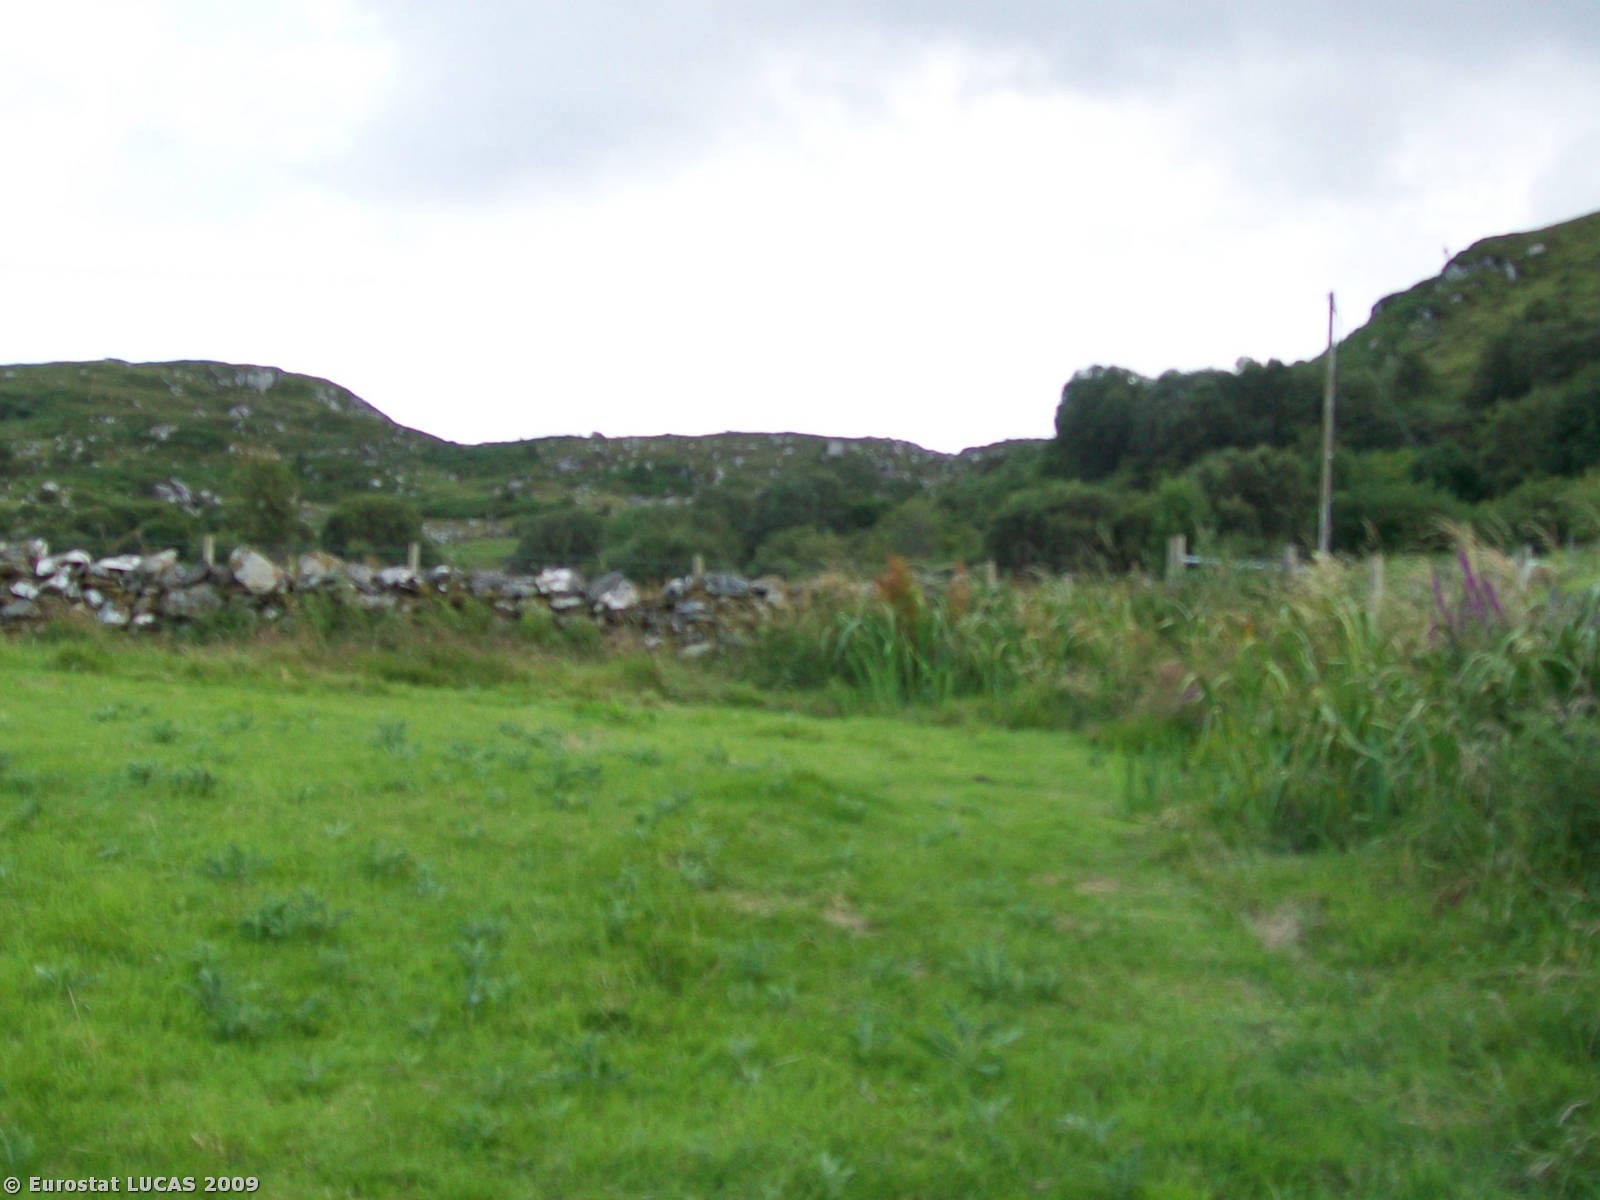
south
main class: Grassland
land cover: Grassland without tree/shrub cover
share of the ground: > 75 %
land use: Agriculture (excluding fallow land and kitchen gardens)
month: July
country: IE
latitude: 53.7643
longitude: -9.5772
